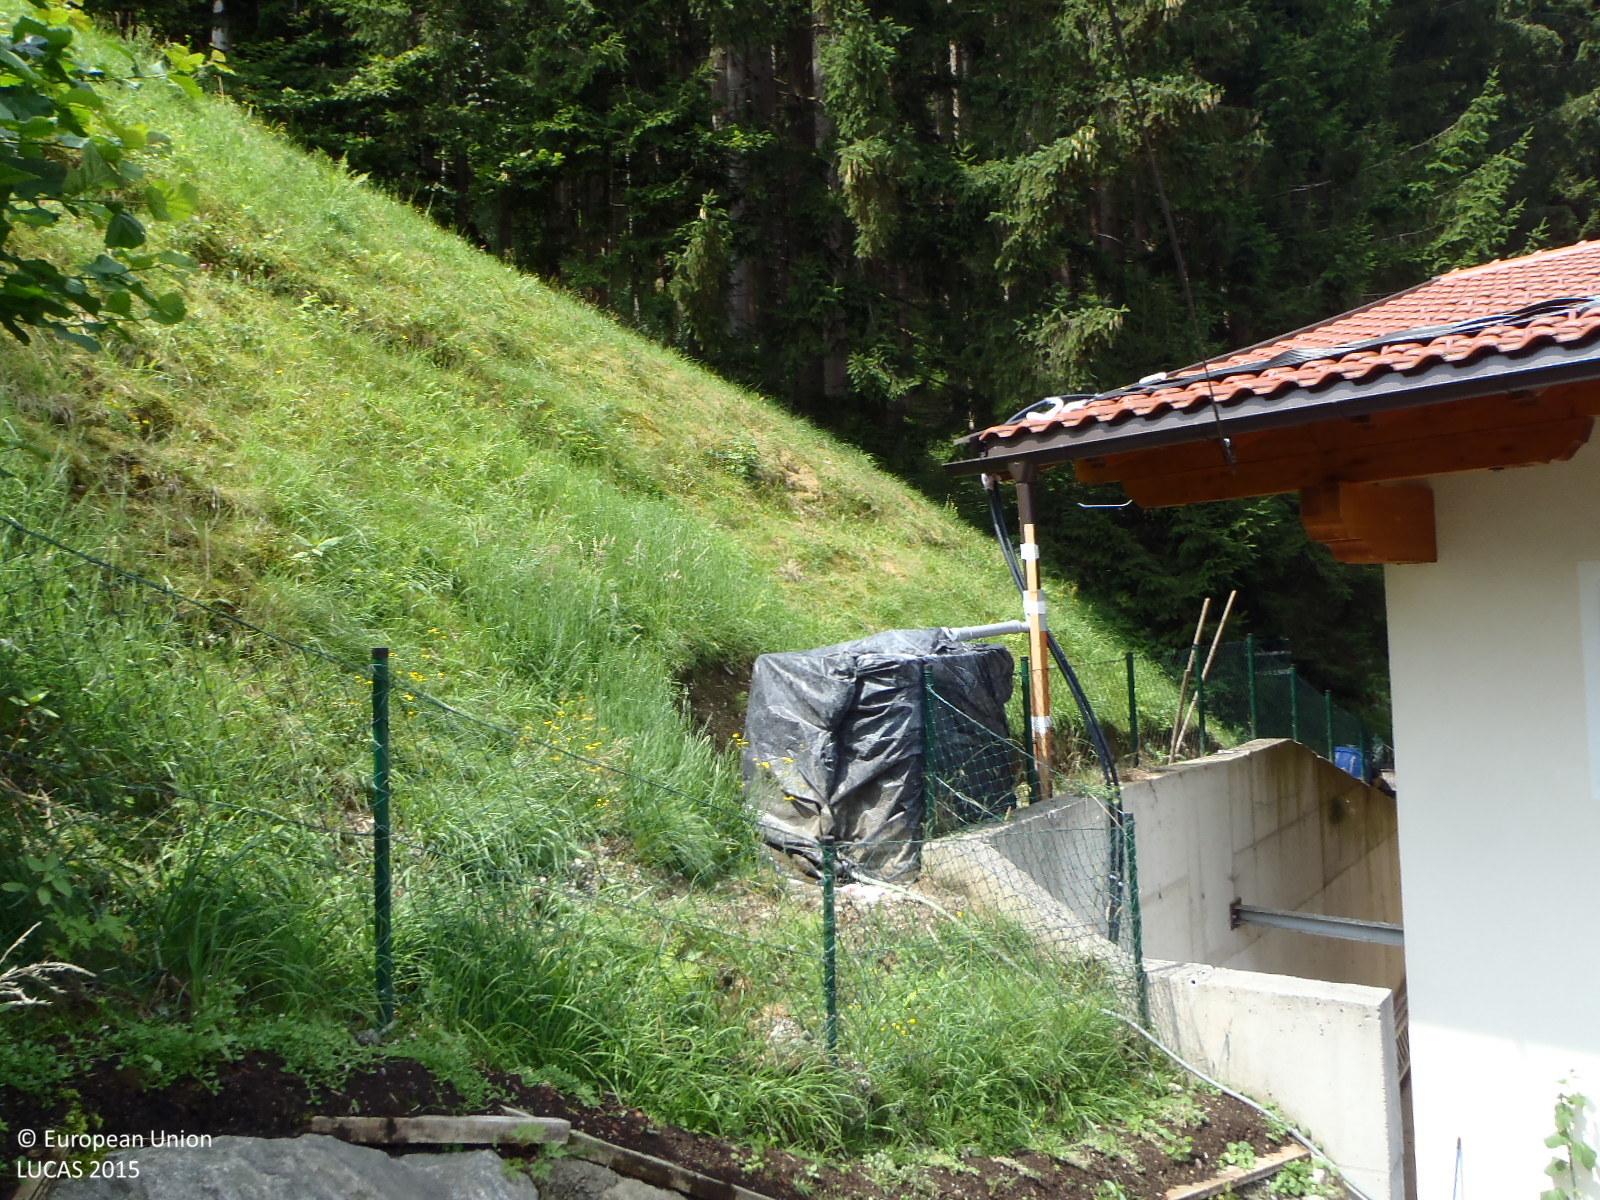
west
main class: Grassland
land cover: Grassland without tree/shrub cover
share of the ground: > 75 %
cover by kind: herbaceous plants 100 %
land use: Agriculture (excluding fallow land and kitchen gardens)
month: July
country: AT
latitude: 47.3261
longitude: 11.8377
